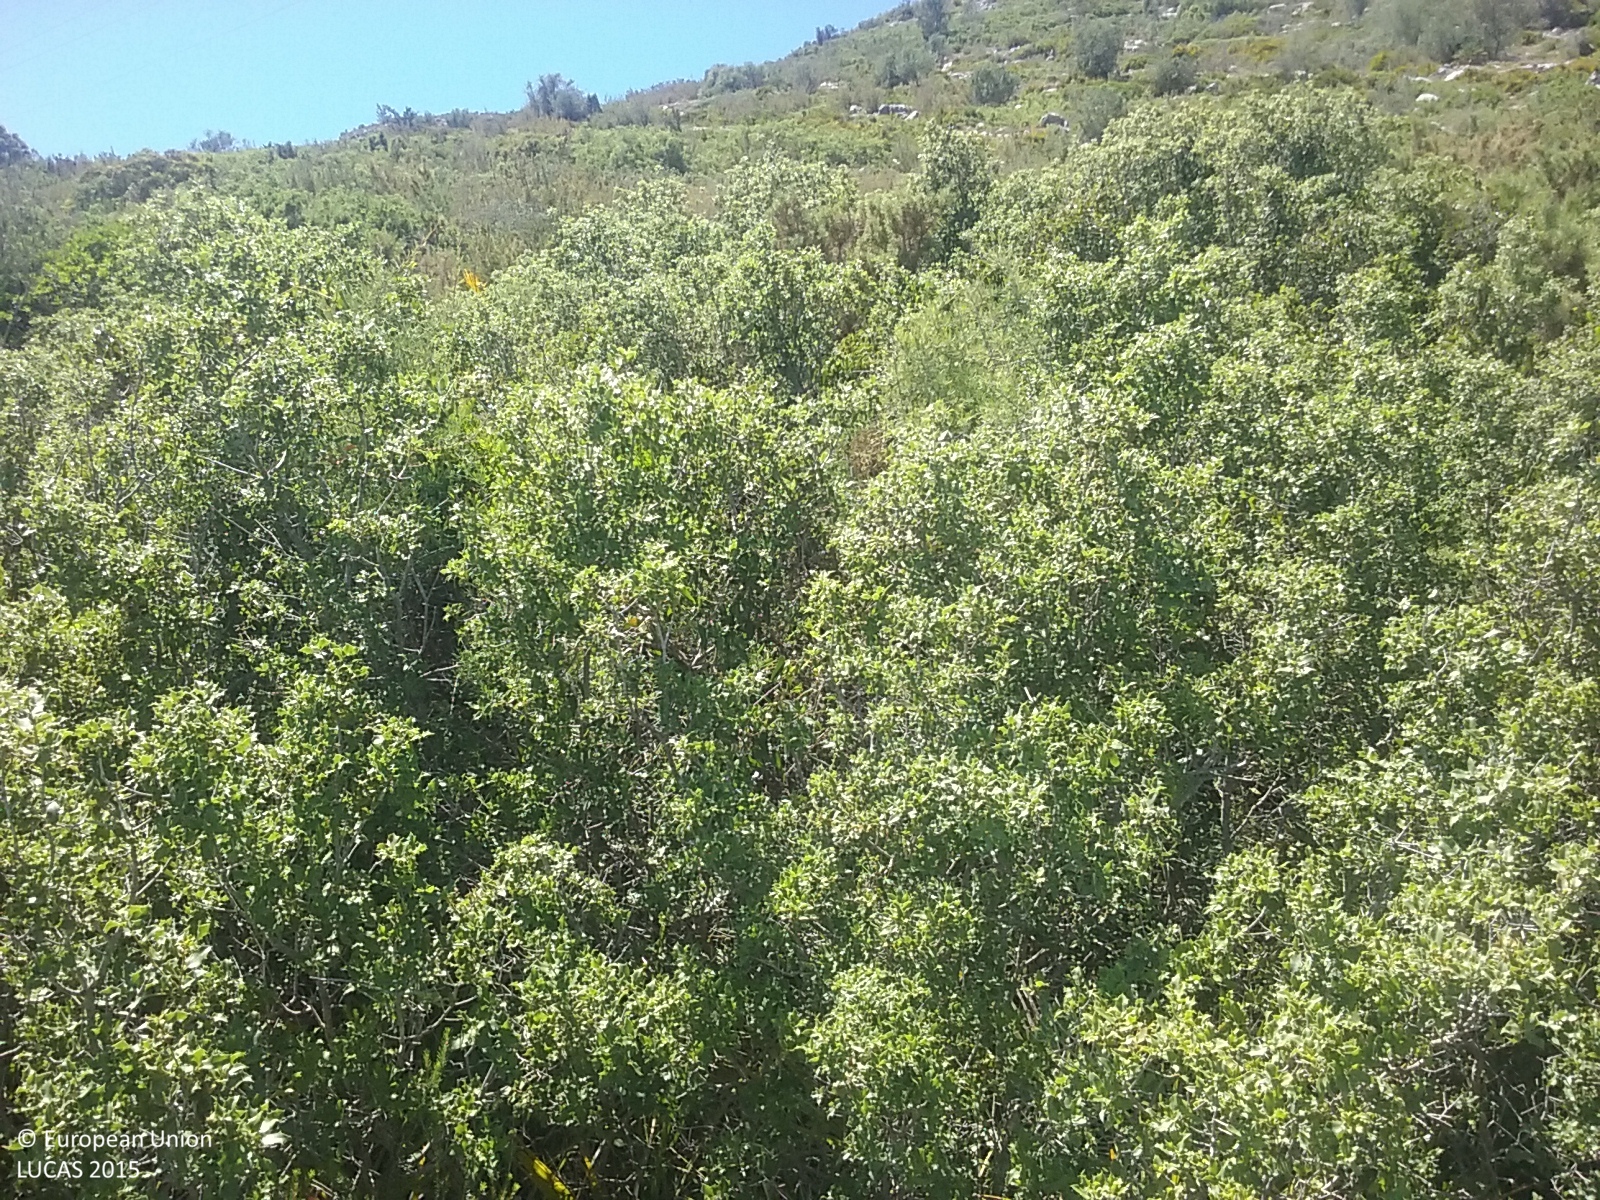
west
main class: Shrubland
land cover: Shrubland with sparse tree cover
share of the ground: > 75 %
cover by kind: shrubs 90 %, broadleaved forest trees 5 %
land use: Semi-natural and natural areas not in use
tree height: < 5 m
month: May
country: ES
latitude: 40.3890
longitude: 0.3251
